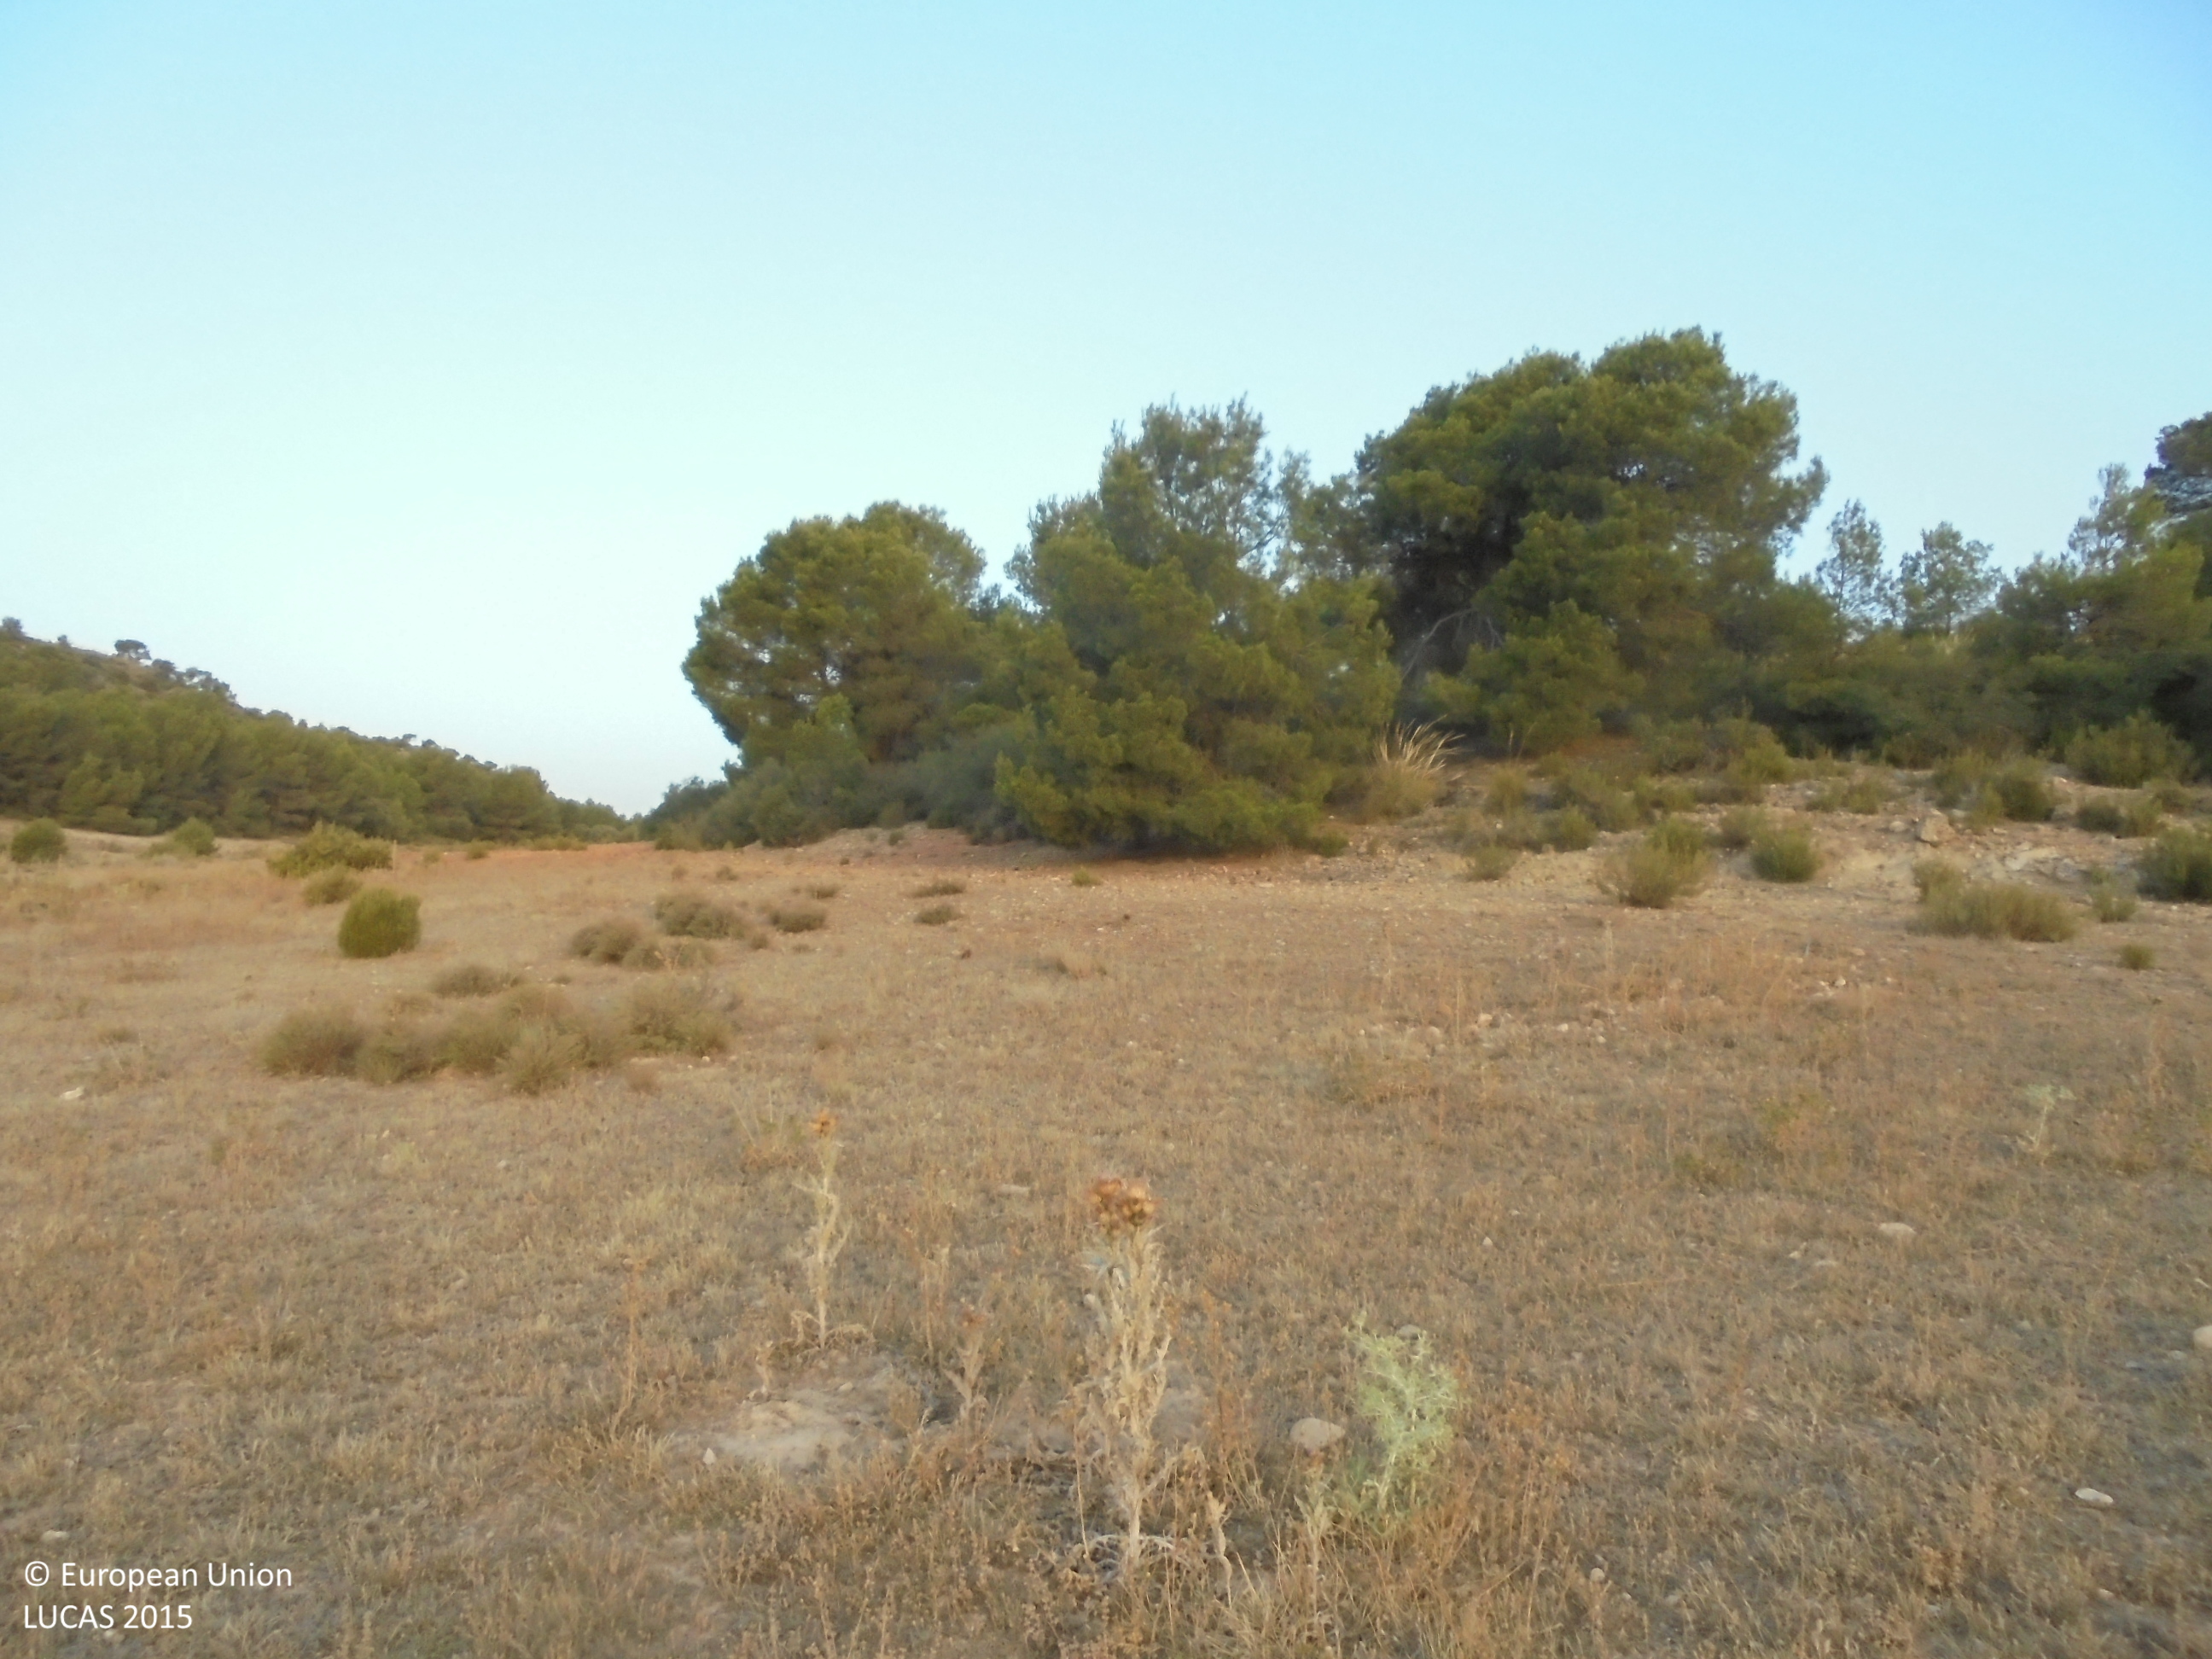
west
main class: Grassland
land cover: Grassland without tree/shrub cover
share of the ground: > 75 %
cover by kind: herbaceous plants 80 %, unconsolidated bare surface 15 %, shrubs 5 %
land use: Abandoned areas
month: July
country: ES
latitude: 38.7428
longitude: -1.6970
